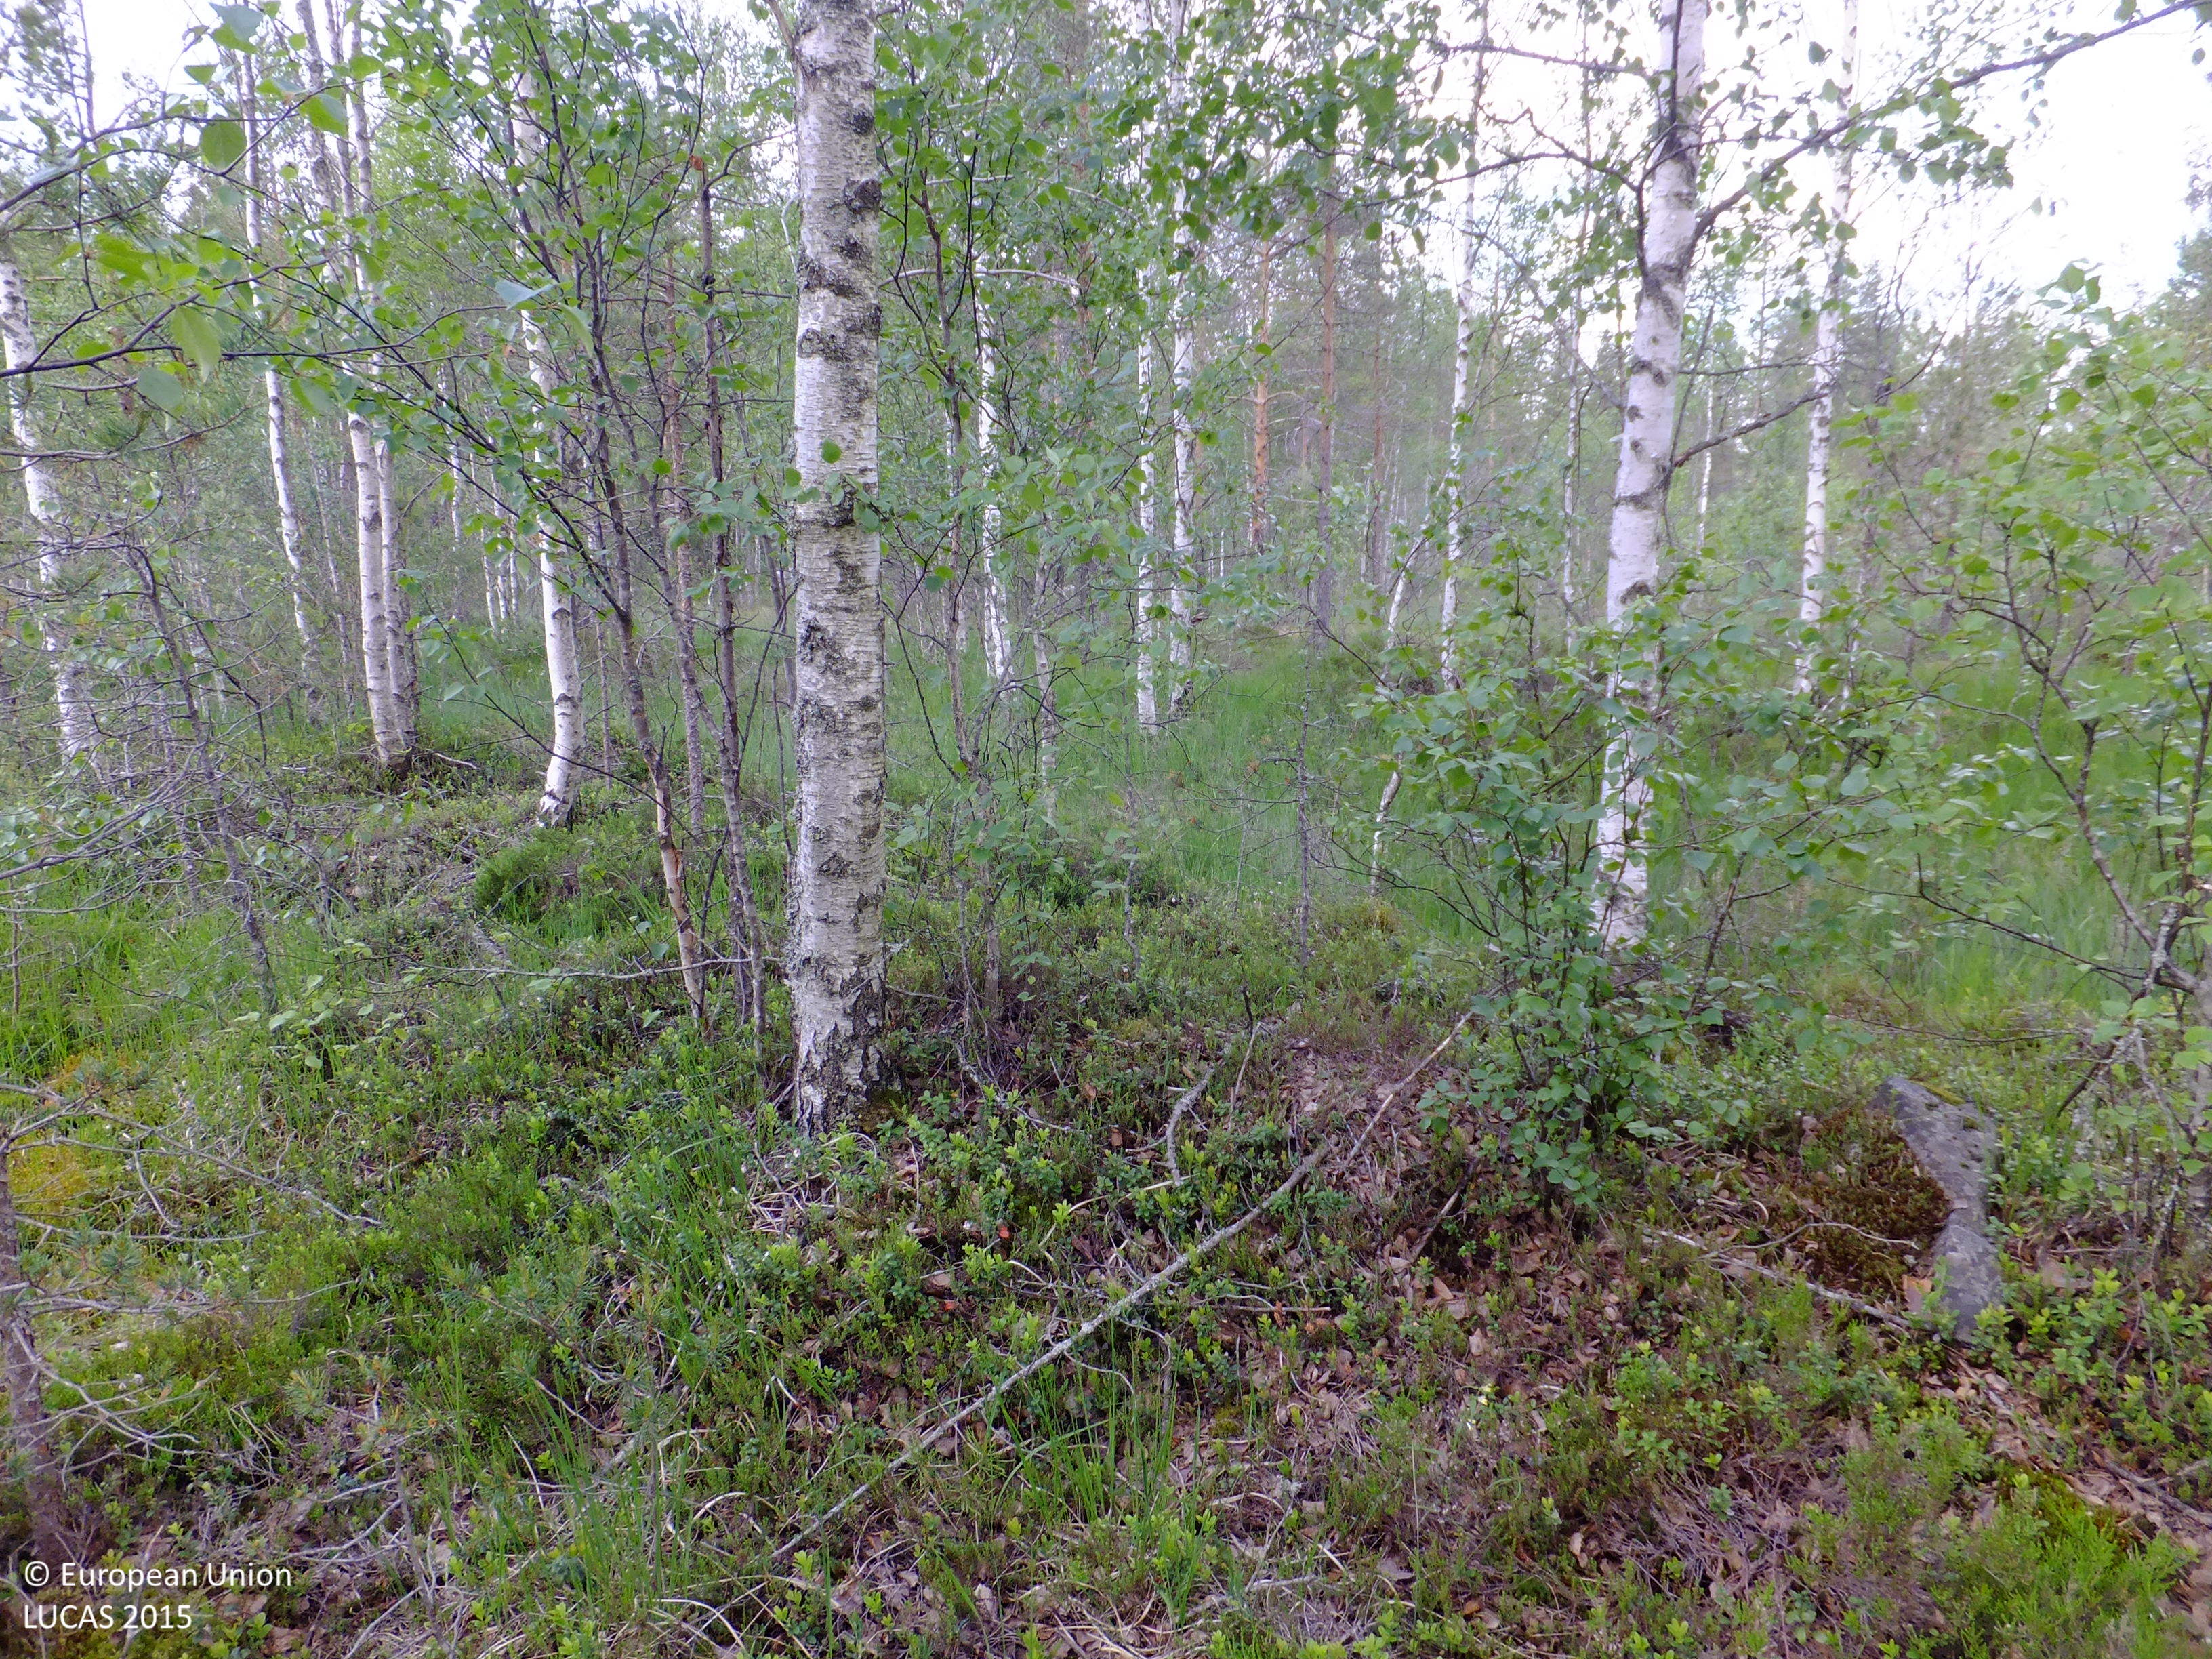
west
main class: Woodland
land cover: Pine dominated mixed woodland
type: boreal forest
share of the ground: 25 - 50 %
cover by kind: lichens and mosses 35 %, shrubs 20 %, herbaceous plants 20 %, broadleaved forest trees 15 %, coniferous forest trees 10 %
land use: Forestry
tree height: > 5 m
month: July
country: FI
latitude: 63.3706
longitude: 24.3770
